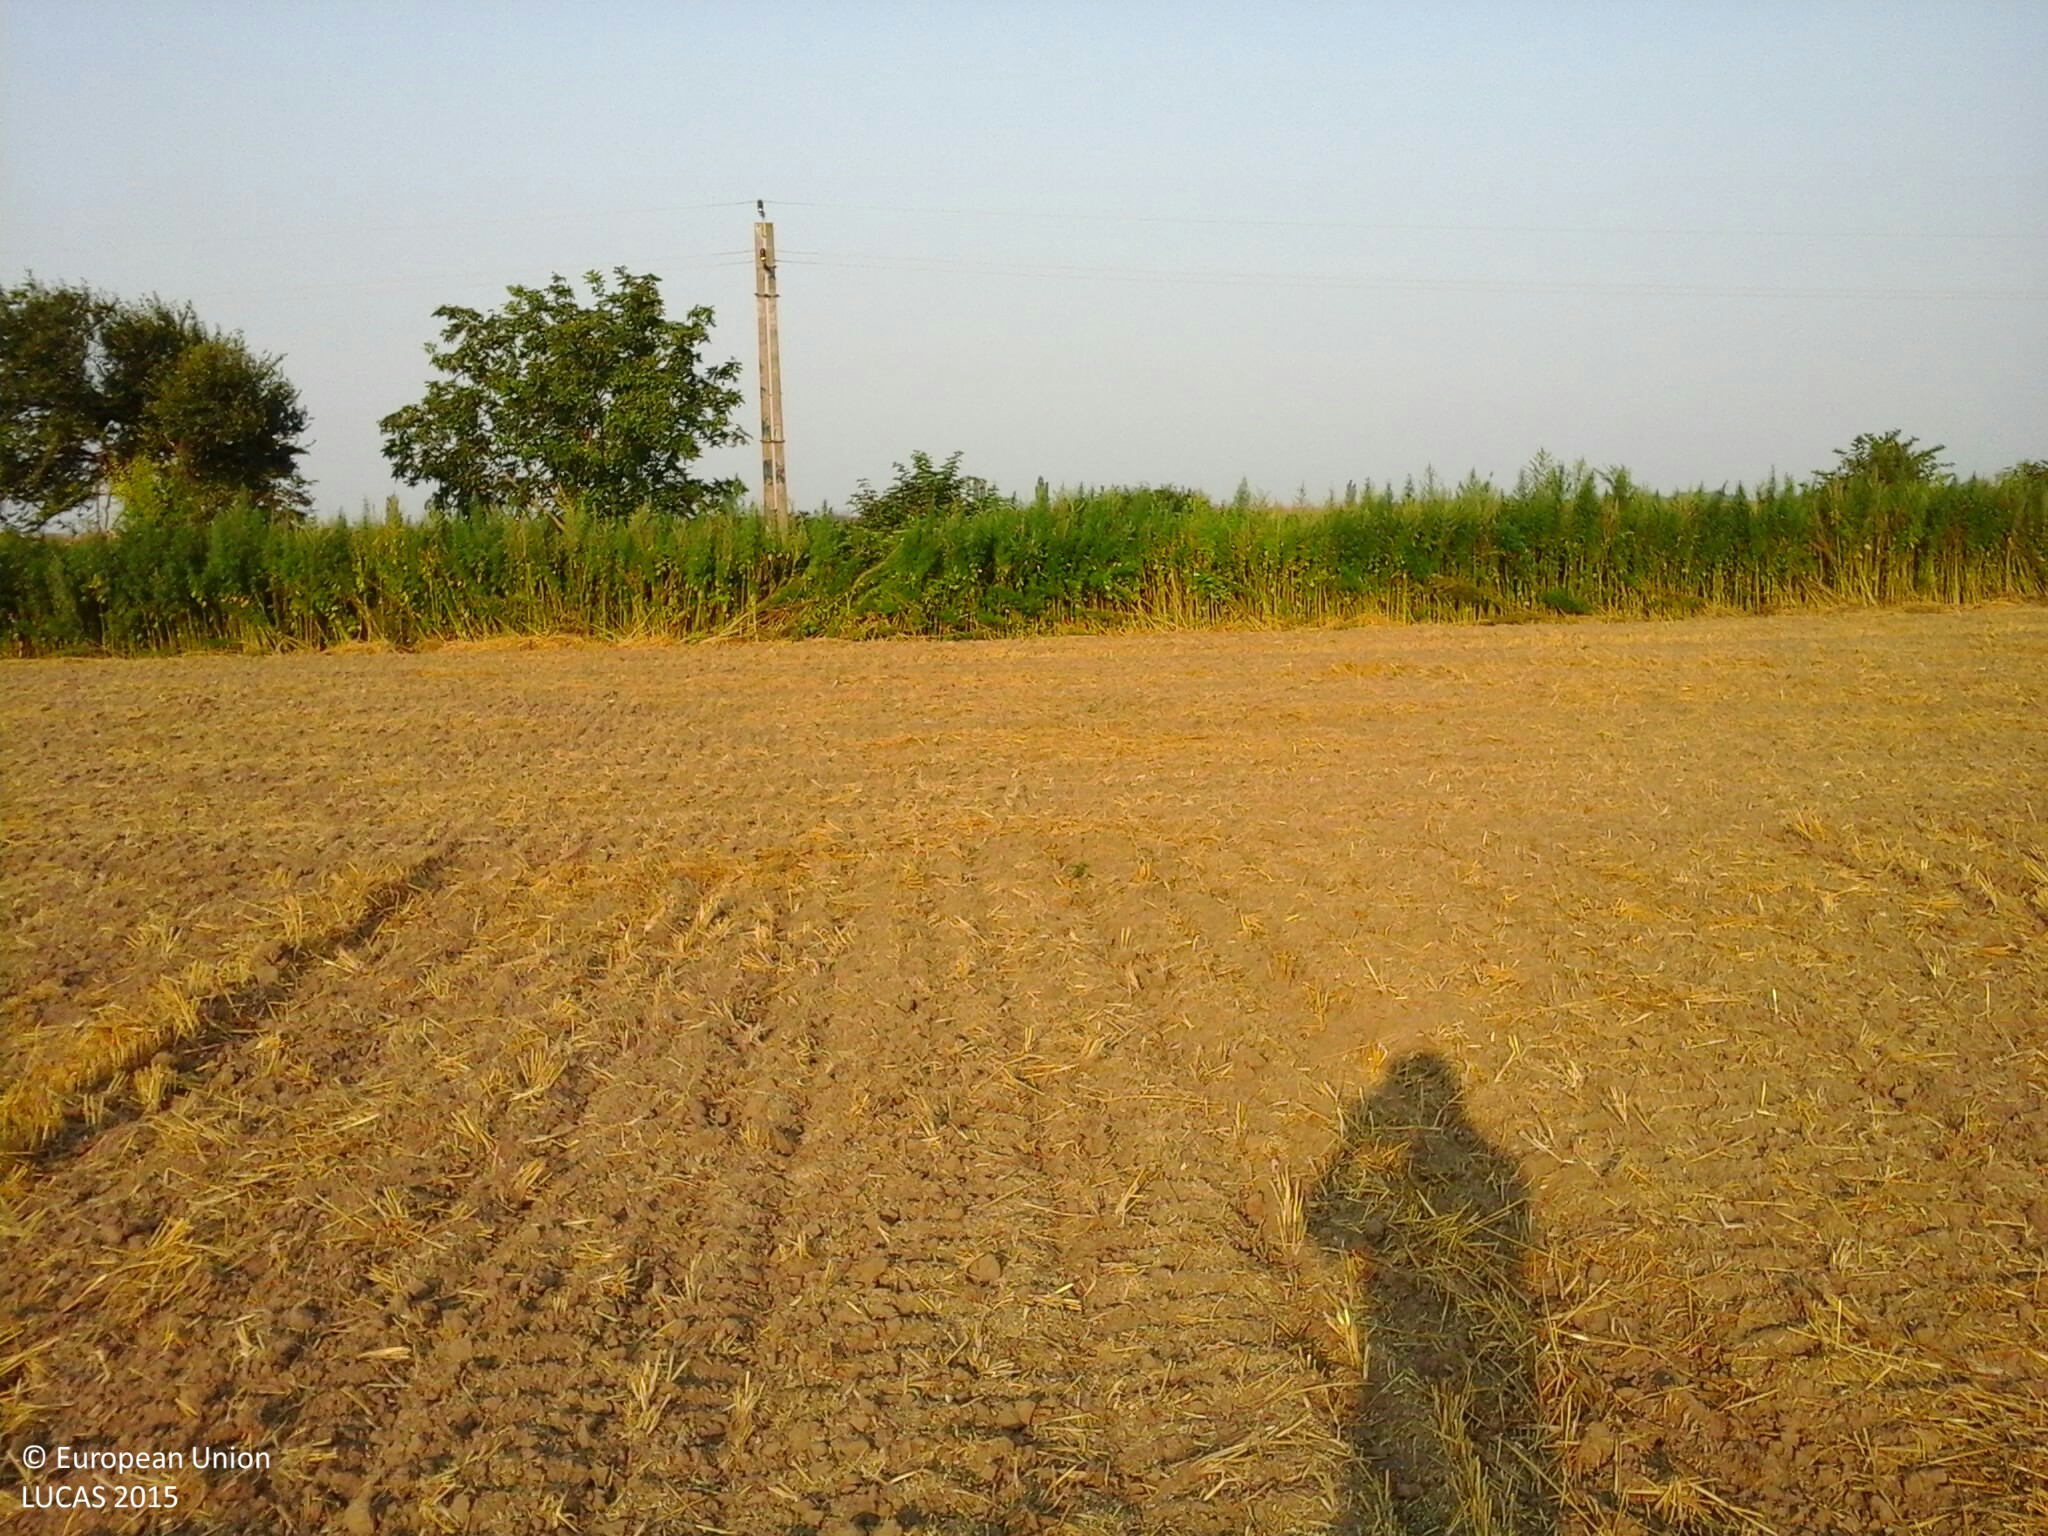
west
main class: Cropland
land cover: Triticale
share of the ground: < 10 %
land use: Agriculture (excluding fallow land and kitchen gardens)
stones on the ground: < 10 %
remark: Harvested field
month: August
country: HU
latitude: 47.1249
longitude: 17.1366
